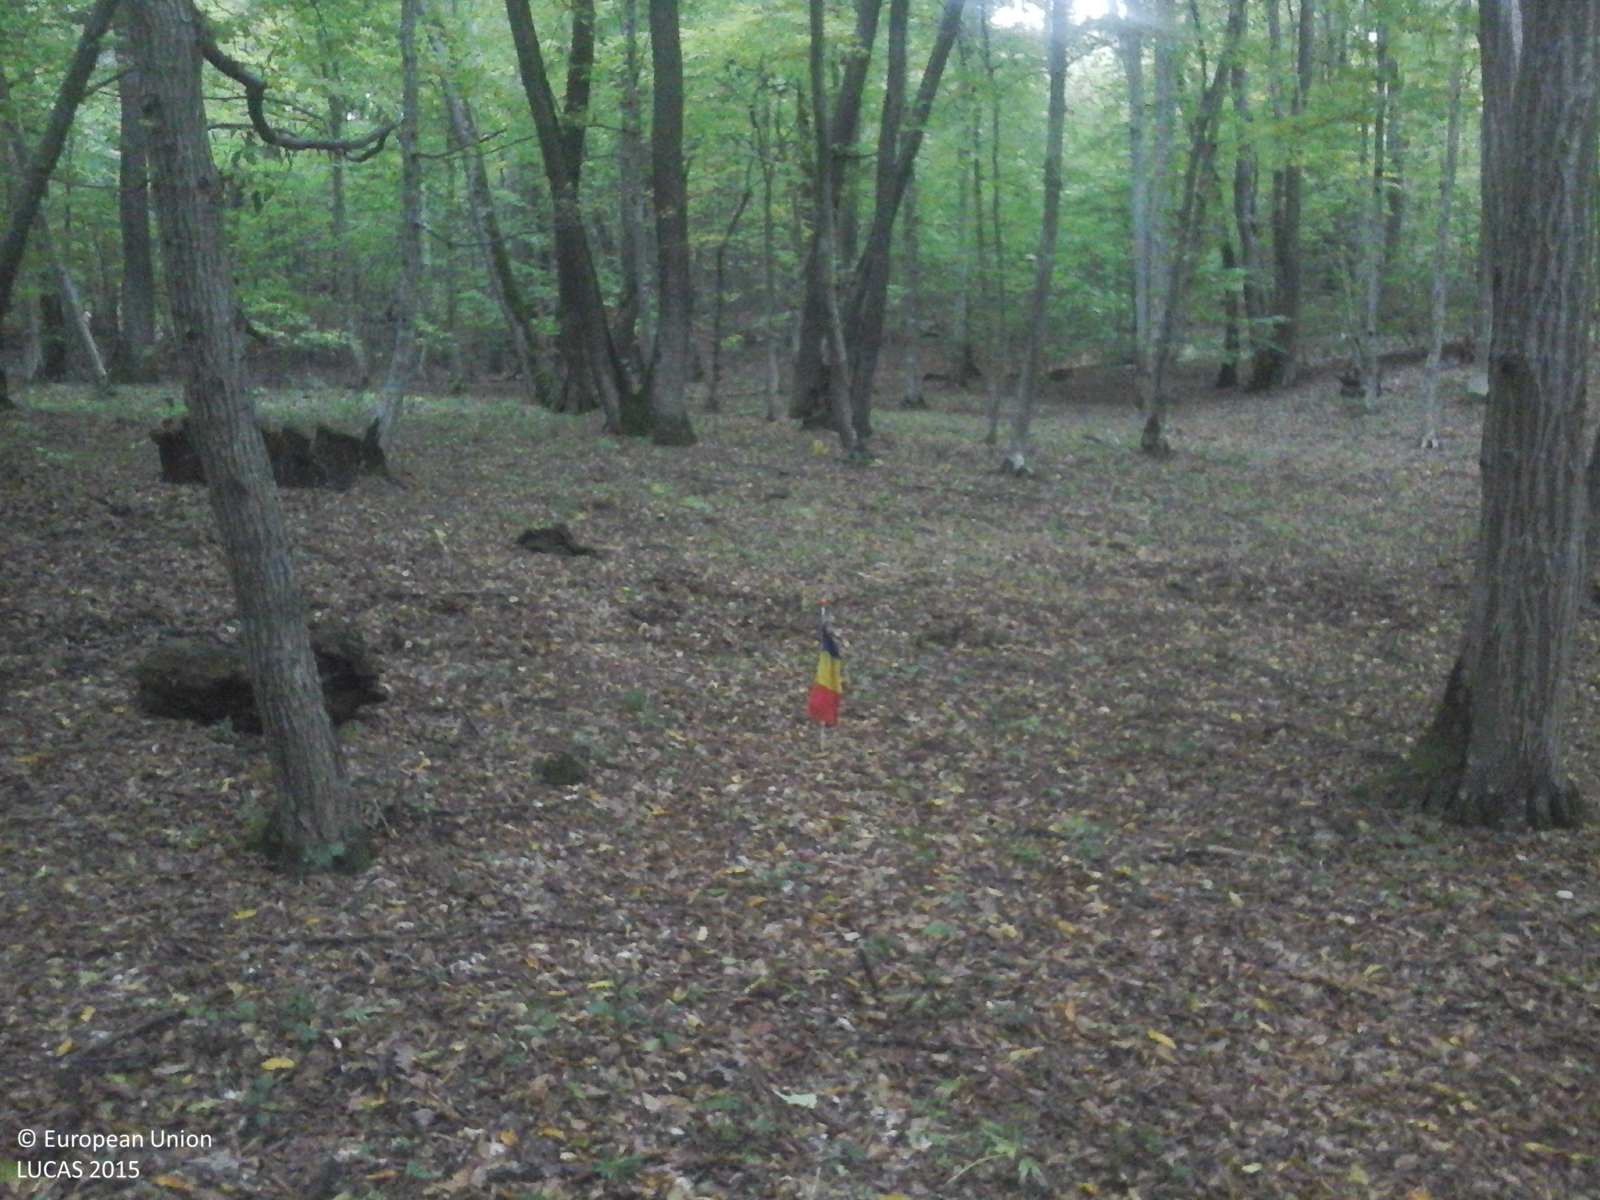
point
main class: Woodland
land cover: Broadleaved woodland
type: beech forest
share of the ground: > 75 %
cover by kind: broadleaved forest trees 100 %
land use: Forestry
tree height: > 5 m
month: October
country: RO
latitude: 45.9880
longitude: 25.0835
